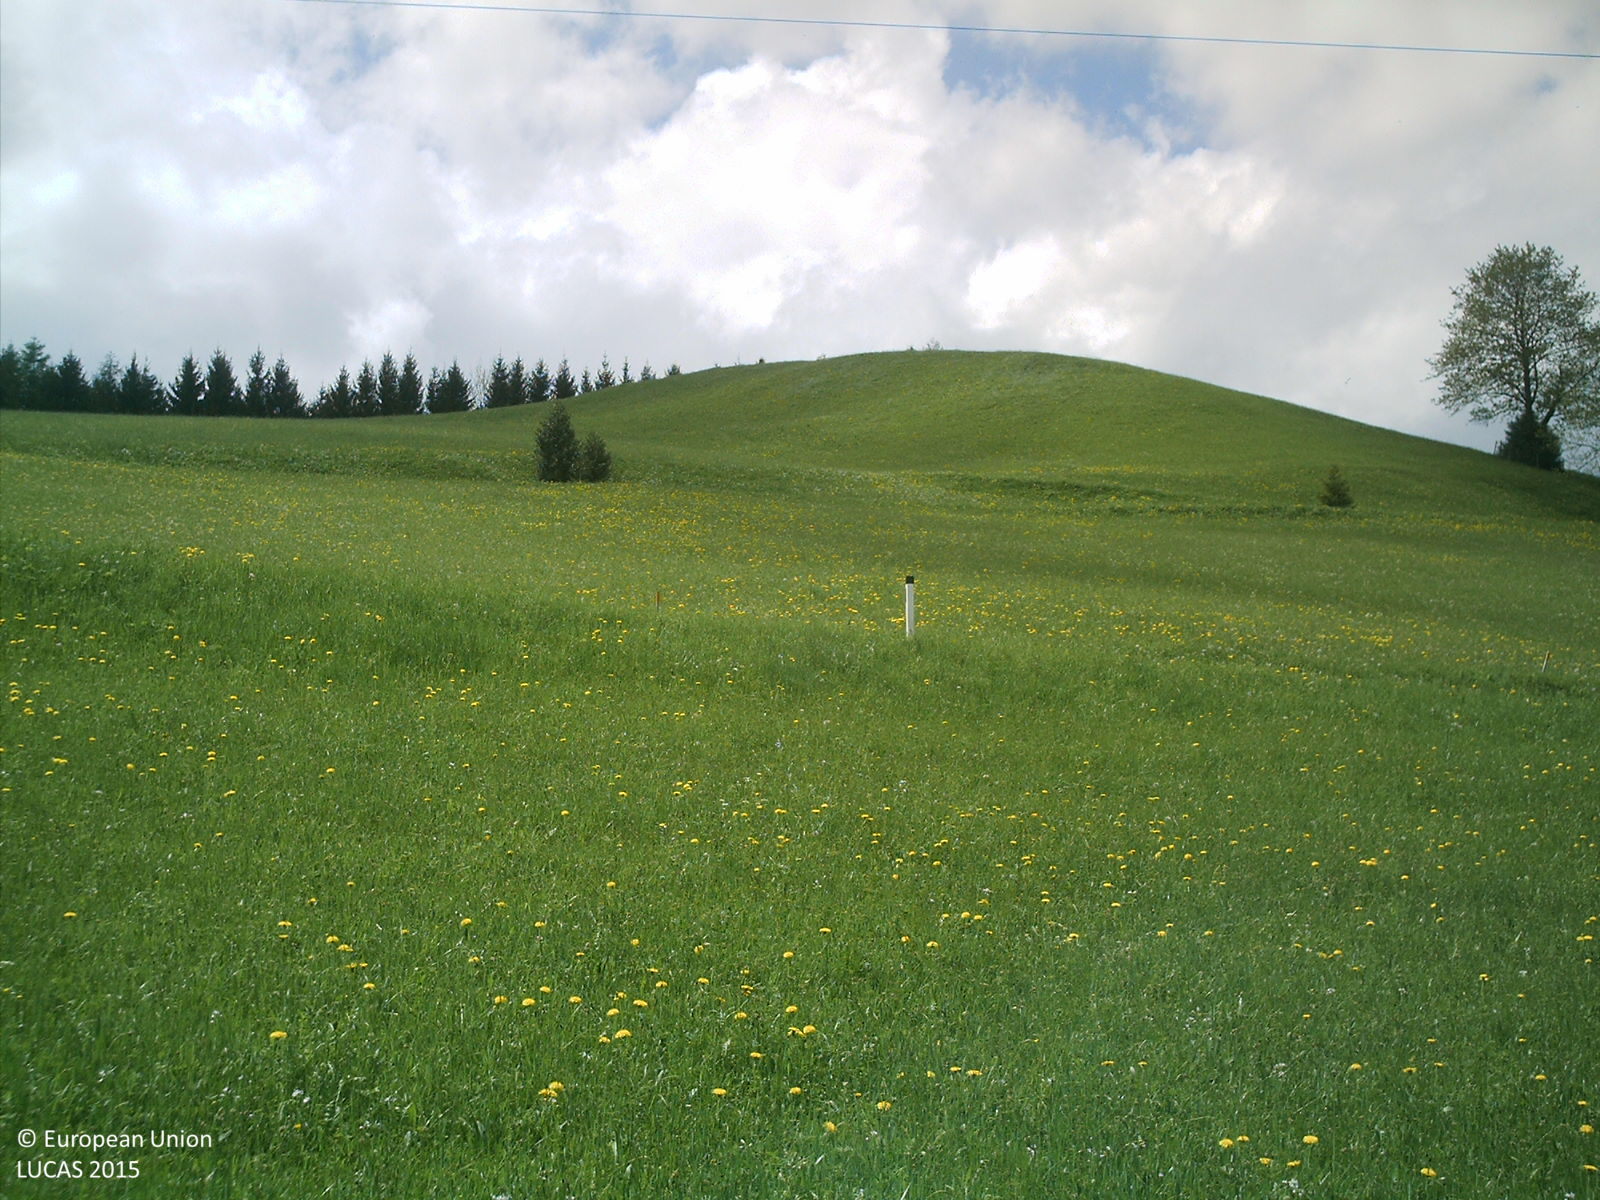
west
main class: Grassland
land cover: Grassland without tree/shrub cover
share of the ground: > 75 %
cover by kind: herbaceous plants 100 %
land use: Agriculture (excluding fallow land and kitchen gardens)
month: May
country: AT
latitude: 47.8928
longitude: 14.1591
